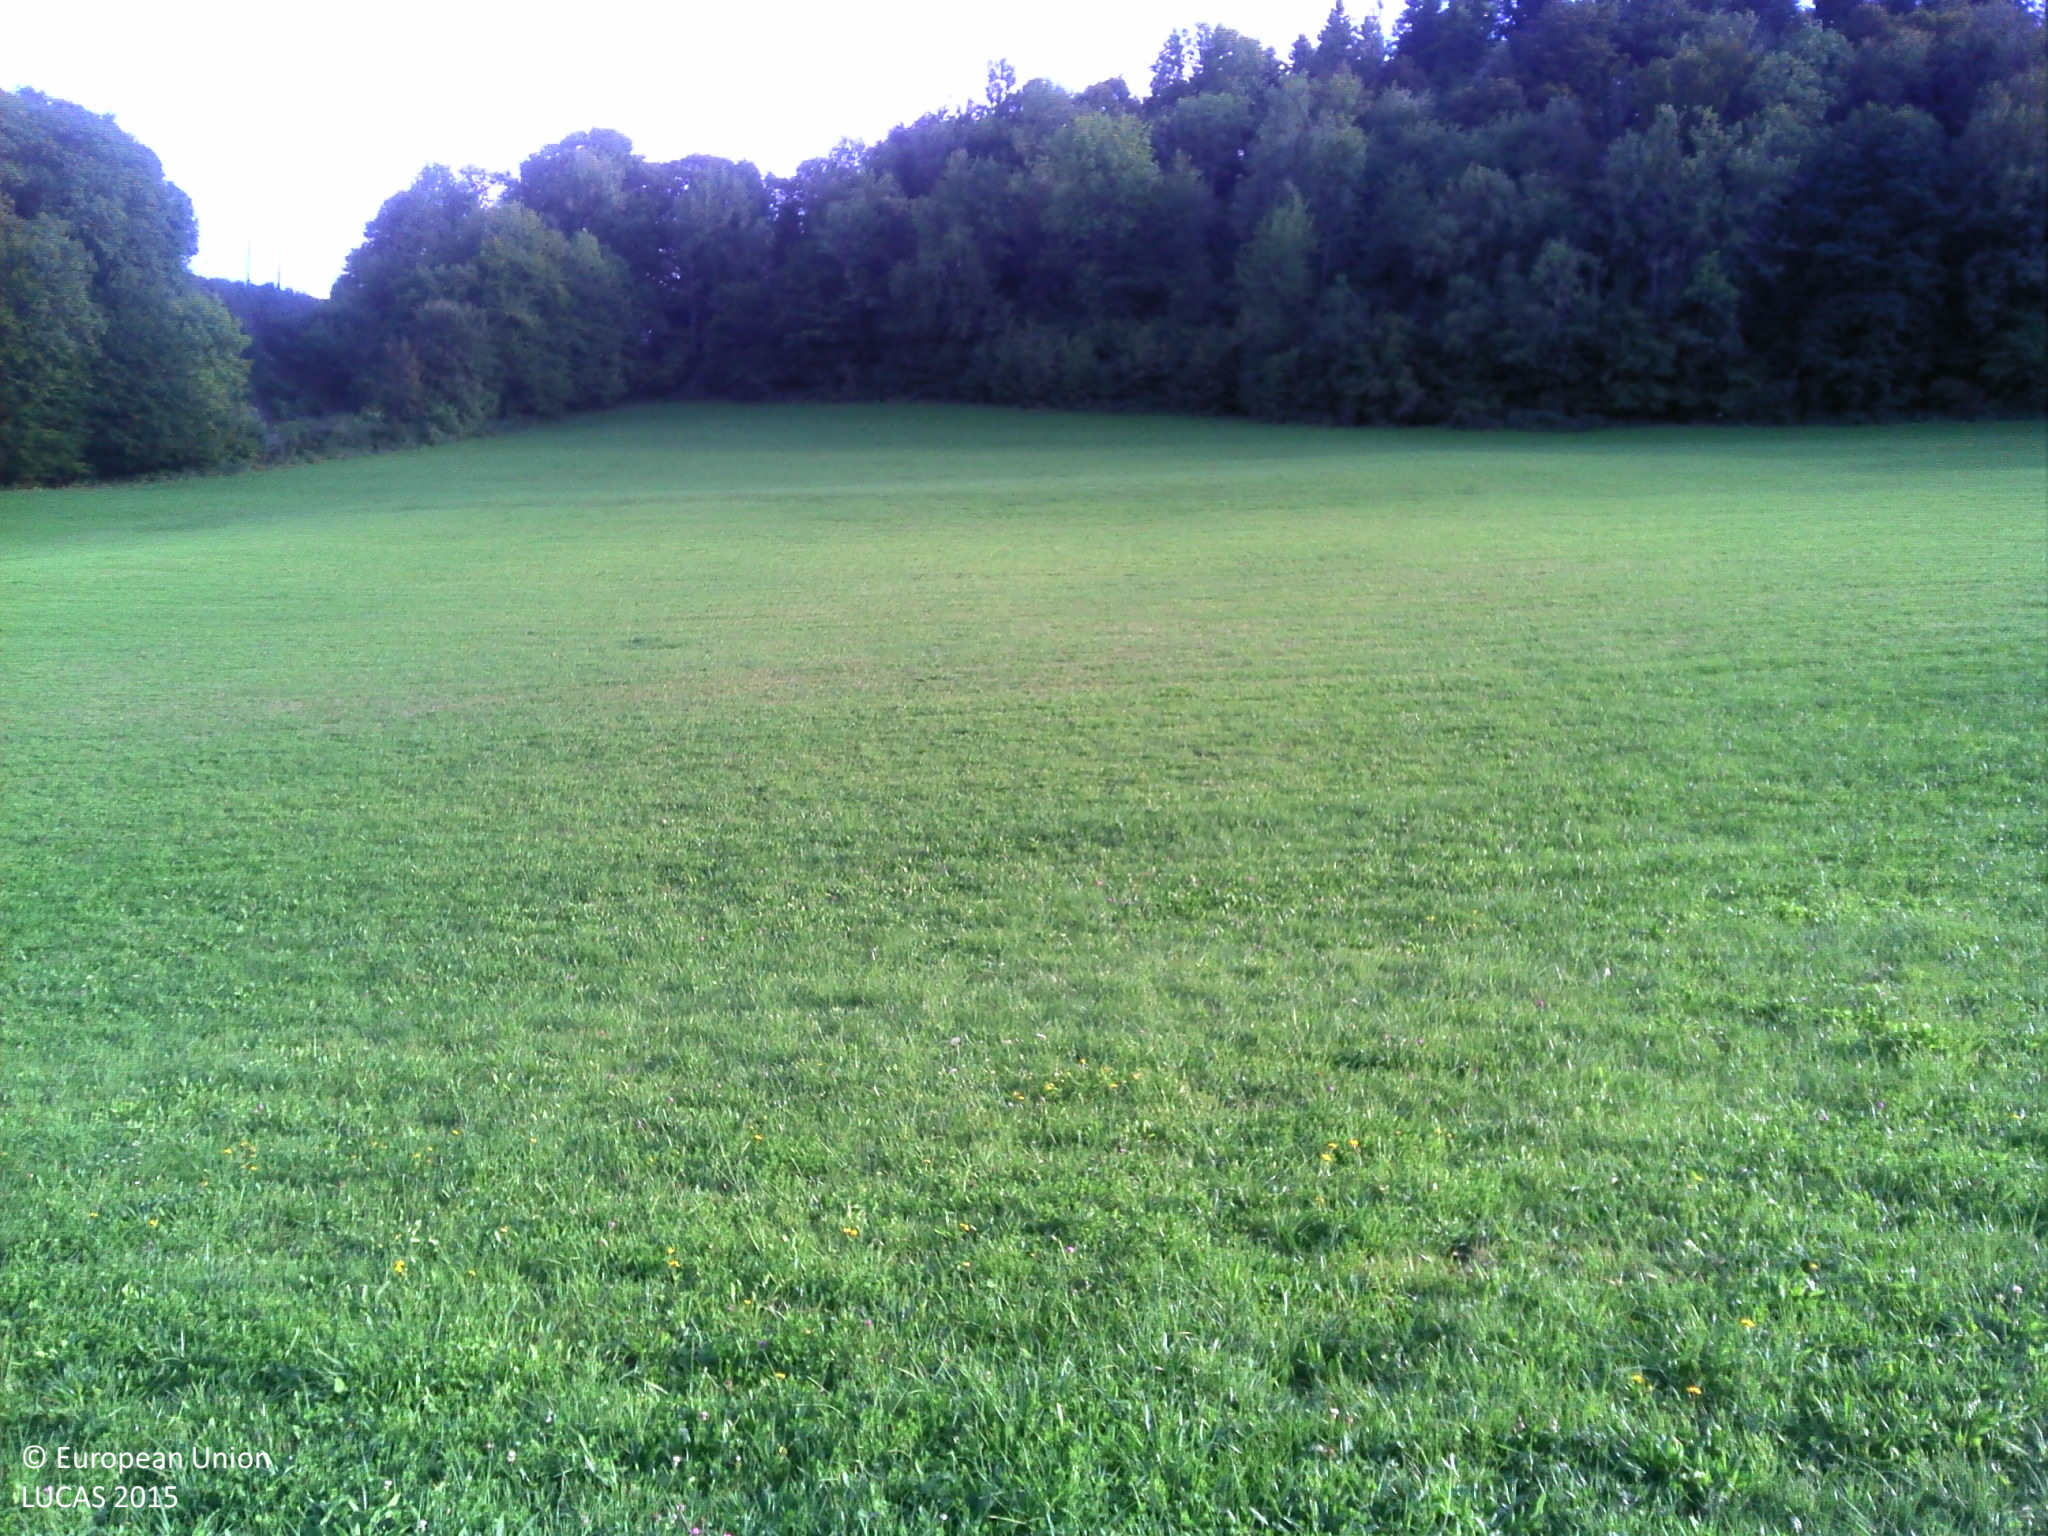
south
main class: Grassland
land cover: Grassland without tree/shrub cover
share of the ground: > 75 %
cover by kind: herbaceous plants 100 %
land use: Agriculture (excluding fallow land and kitchen gardens)
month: September
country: FR
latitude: 47.3708
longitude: 6.3600
